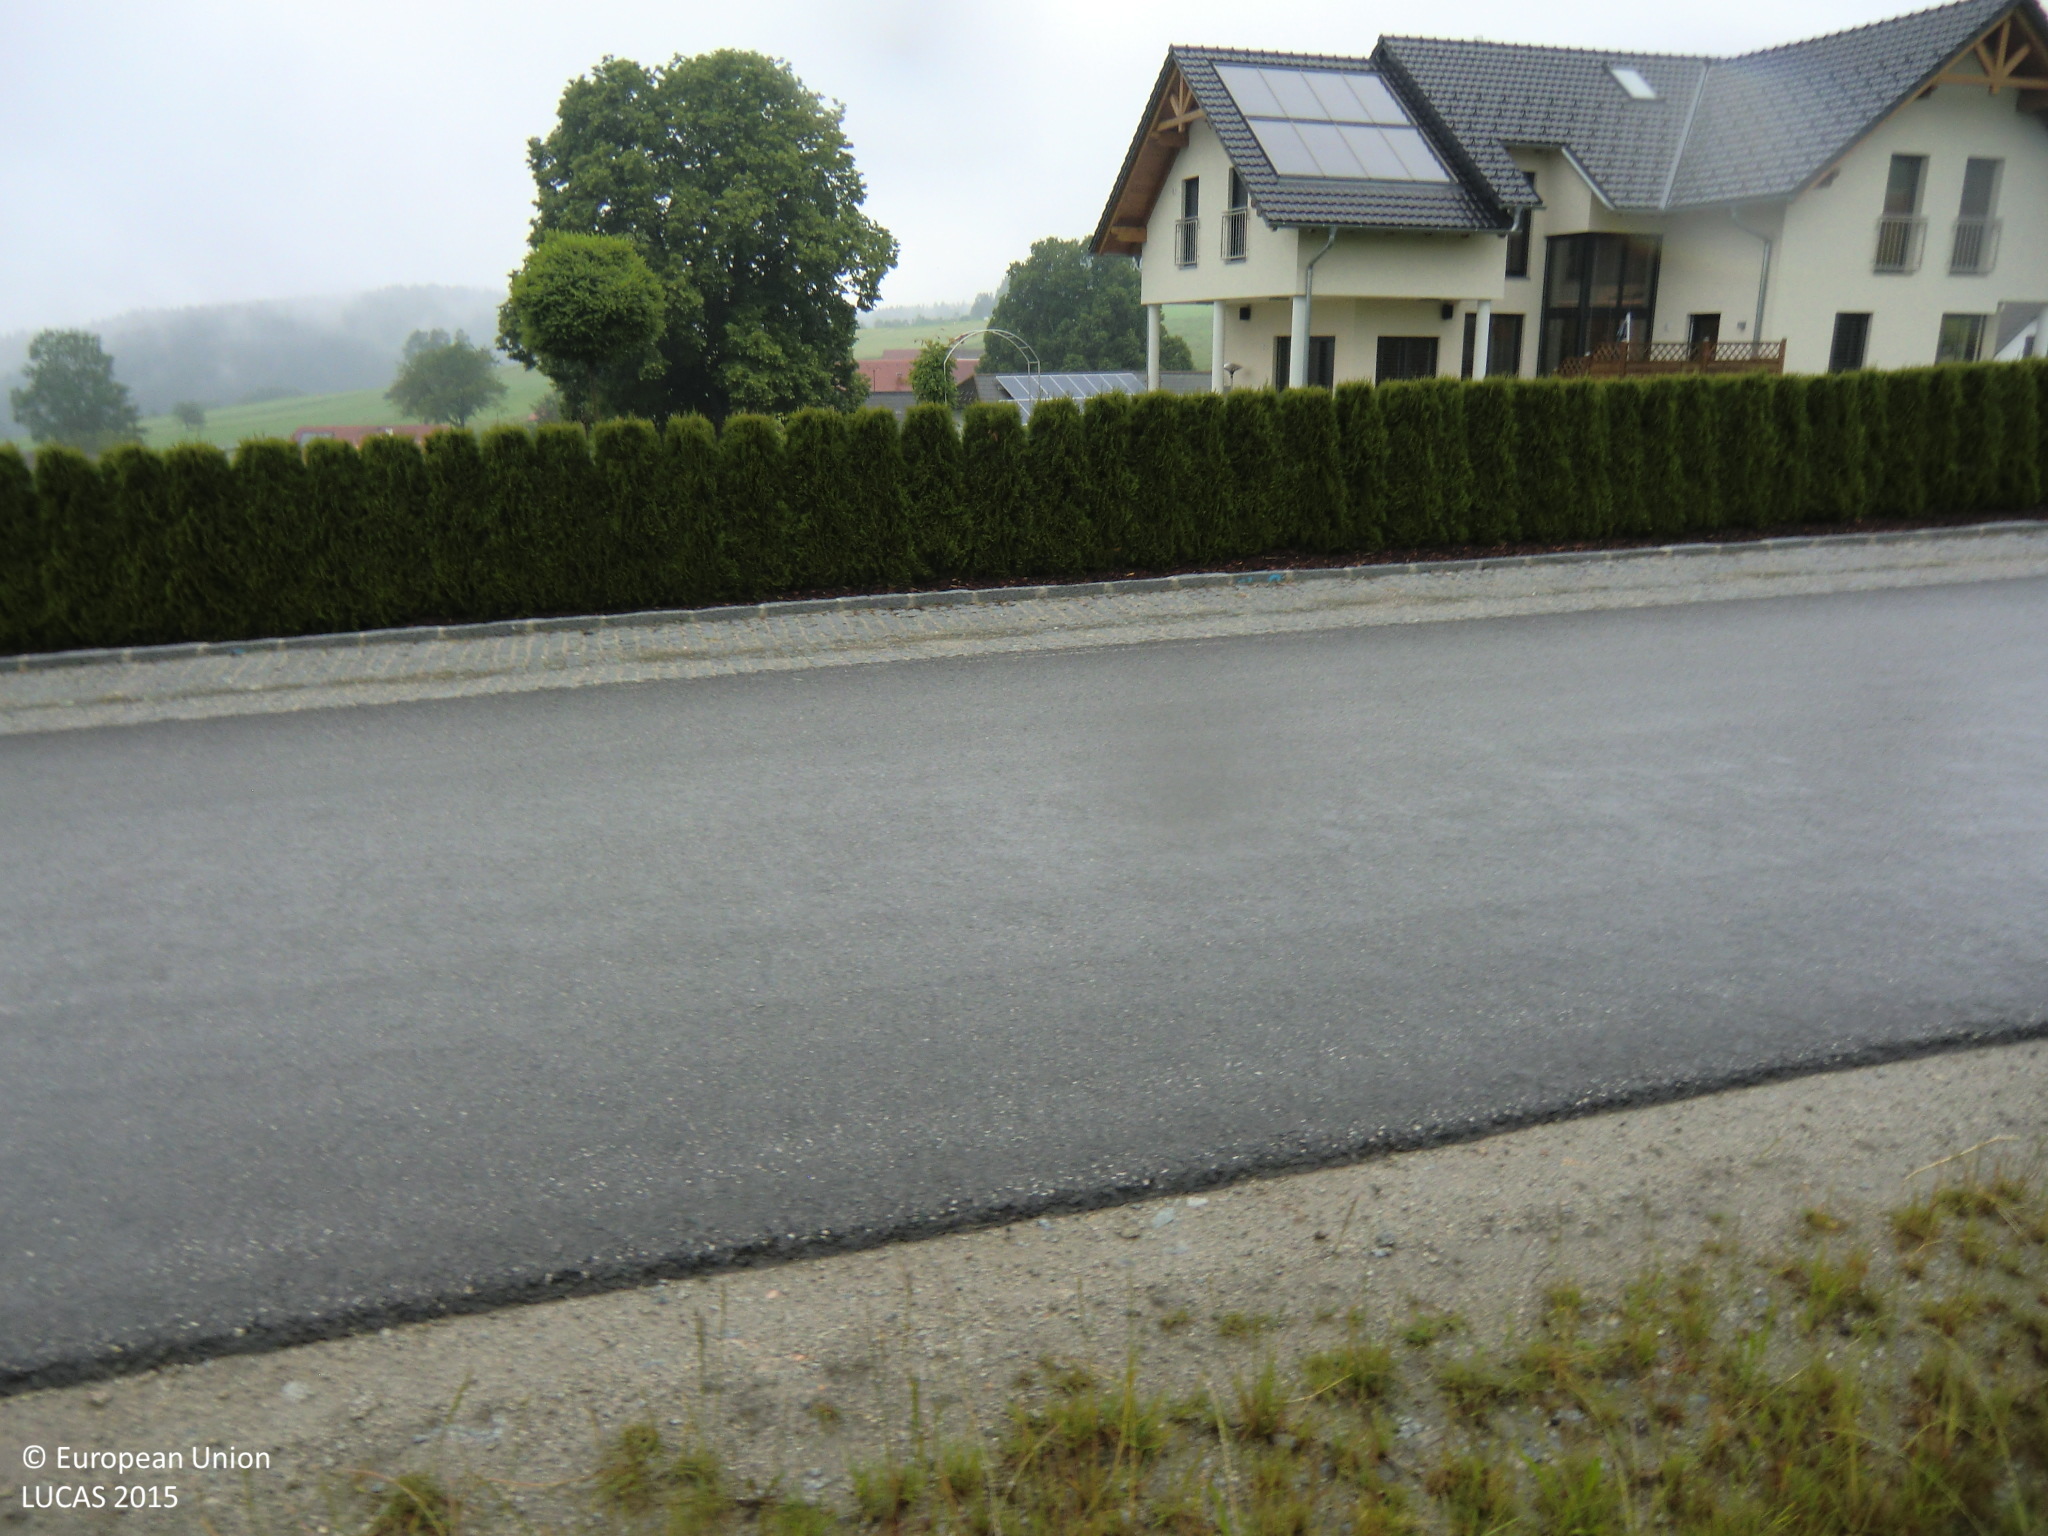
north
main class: Grassland
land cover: Grassland without tree/shrub cover
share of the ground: > 75 %
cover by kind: herbaceous plants 100 %
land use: Agriculture (excluding fallow land and kitchen gardens)
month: June
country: AT
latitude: 48.5974
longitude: 14.5705
